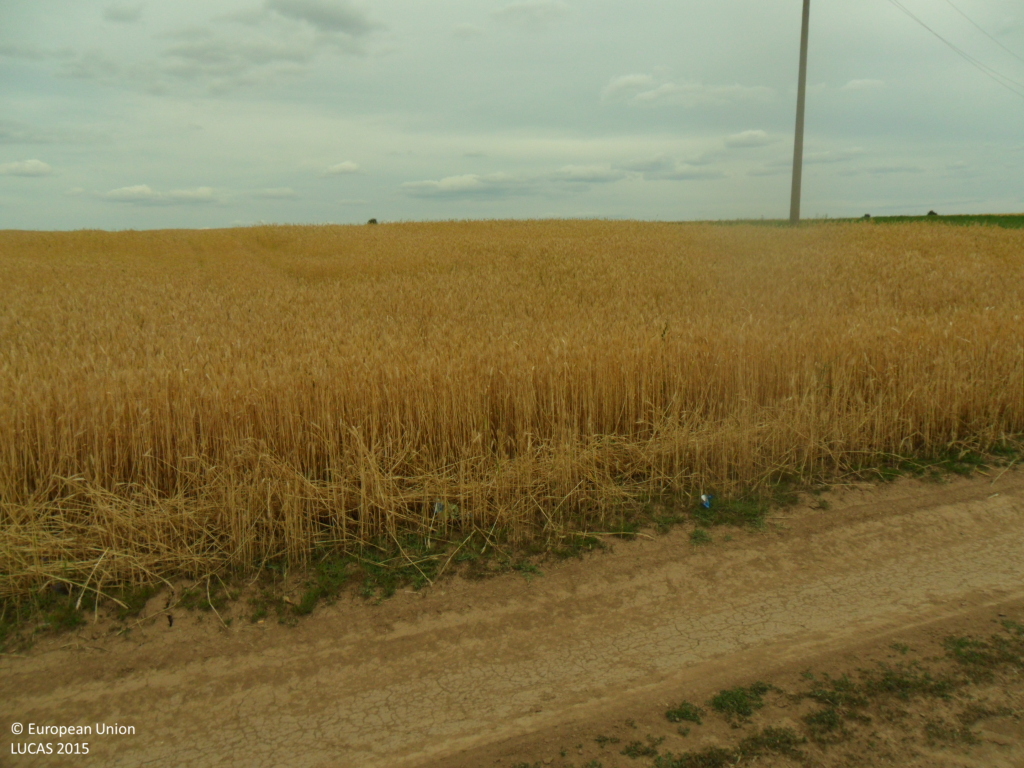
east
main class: Cropland
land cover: Common wheat
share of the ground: > 75 %
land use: Agriculture (excluding fallow land and kitchen gardens)
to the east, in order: Tracks; Common wheat; Electric lines; Common wheat; Sunflower
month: June
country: BG
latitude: 43.6552
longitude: 26.7654
